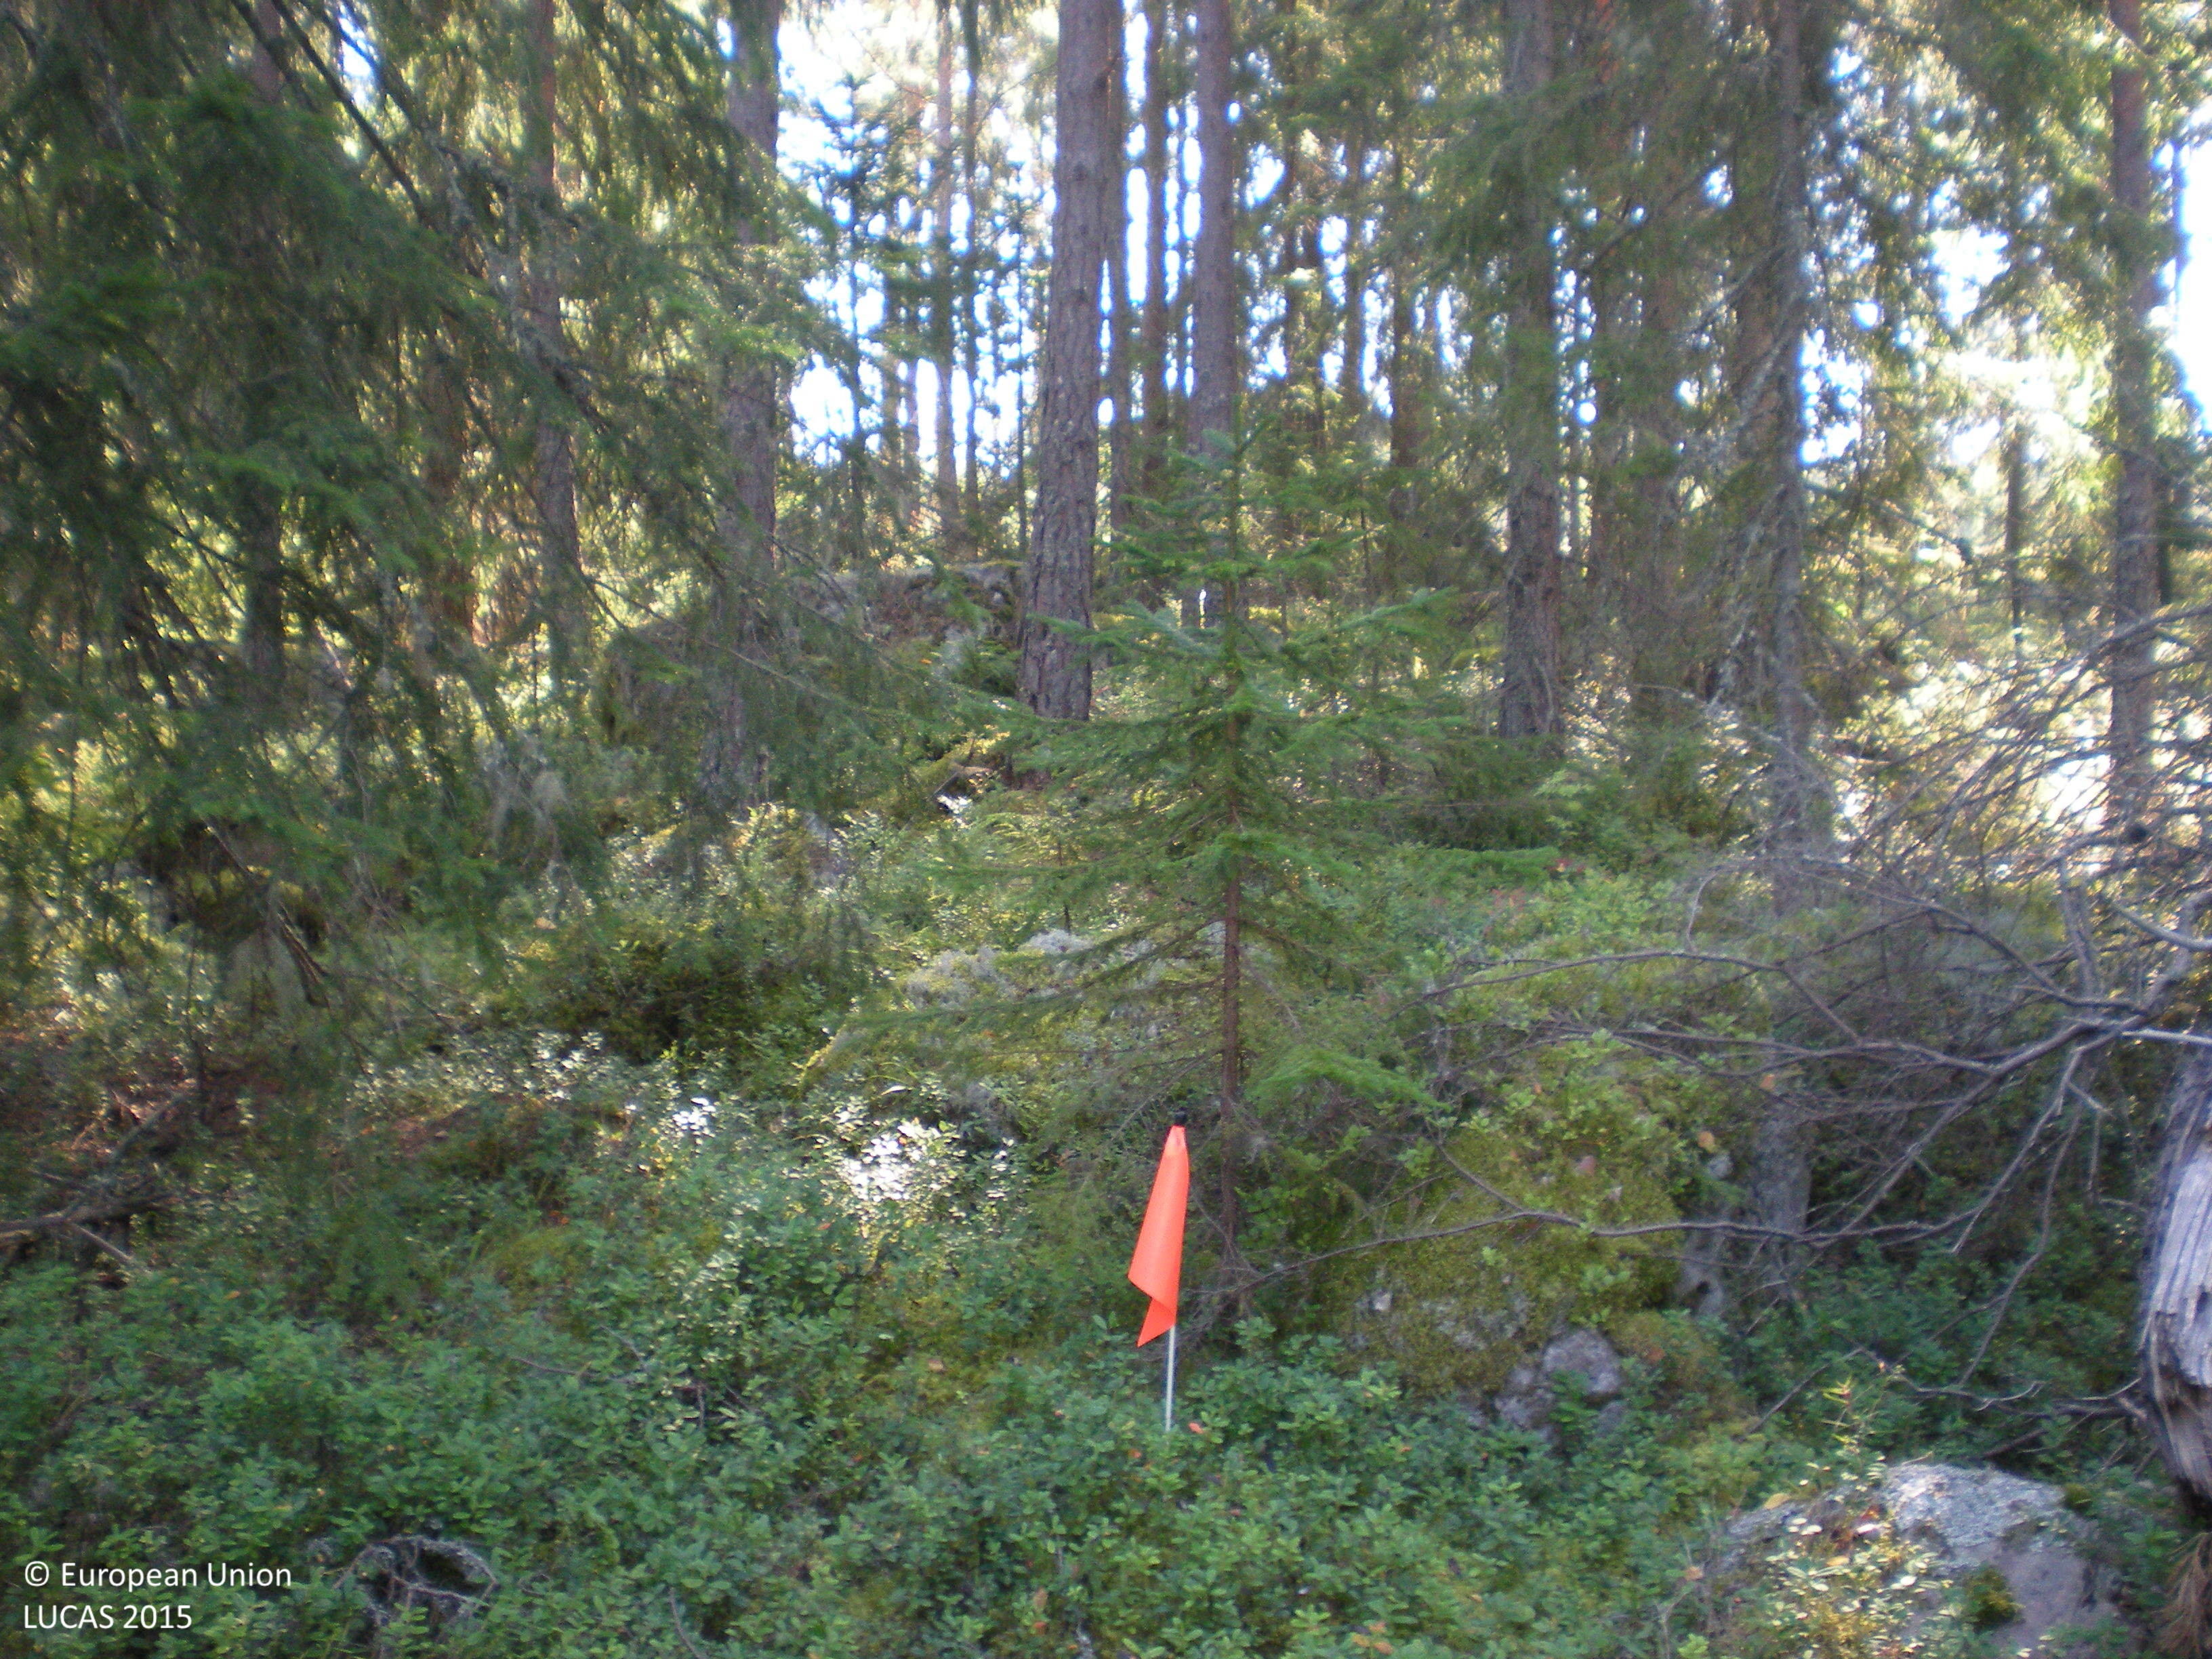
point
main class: Woodland
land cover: Other coniferous woodland
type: boreal forest
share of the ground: 50 - 75 %
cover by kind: coniferous forest trees 65 %, shrubs 20 %, lichens and mosses 15 %
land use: Forestry
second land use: Amenities, museums, leisure
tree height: > 5 m
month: August
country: SE
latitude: 60.5862
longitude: 17.3464
